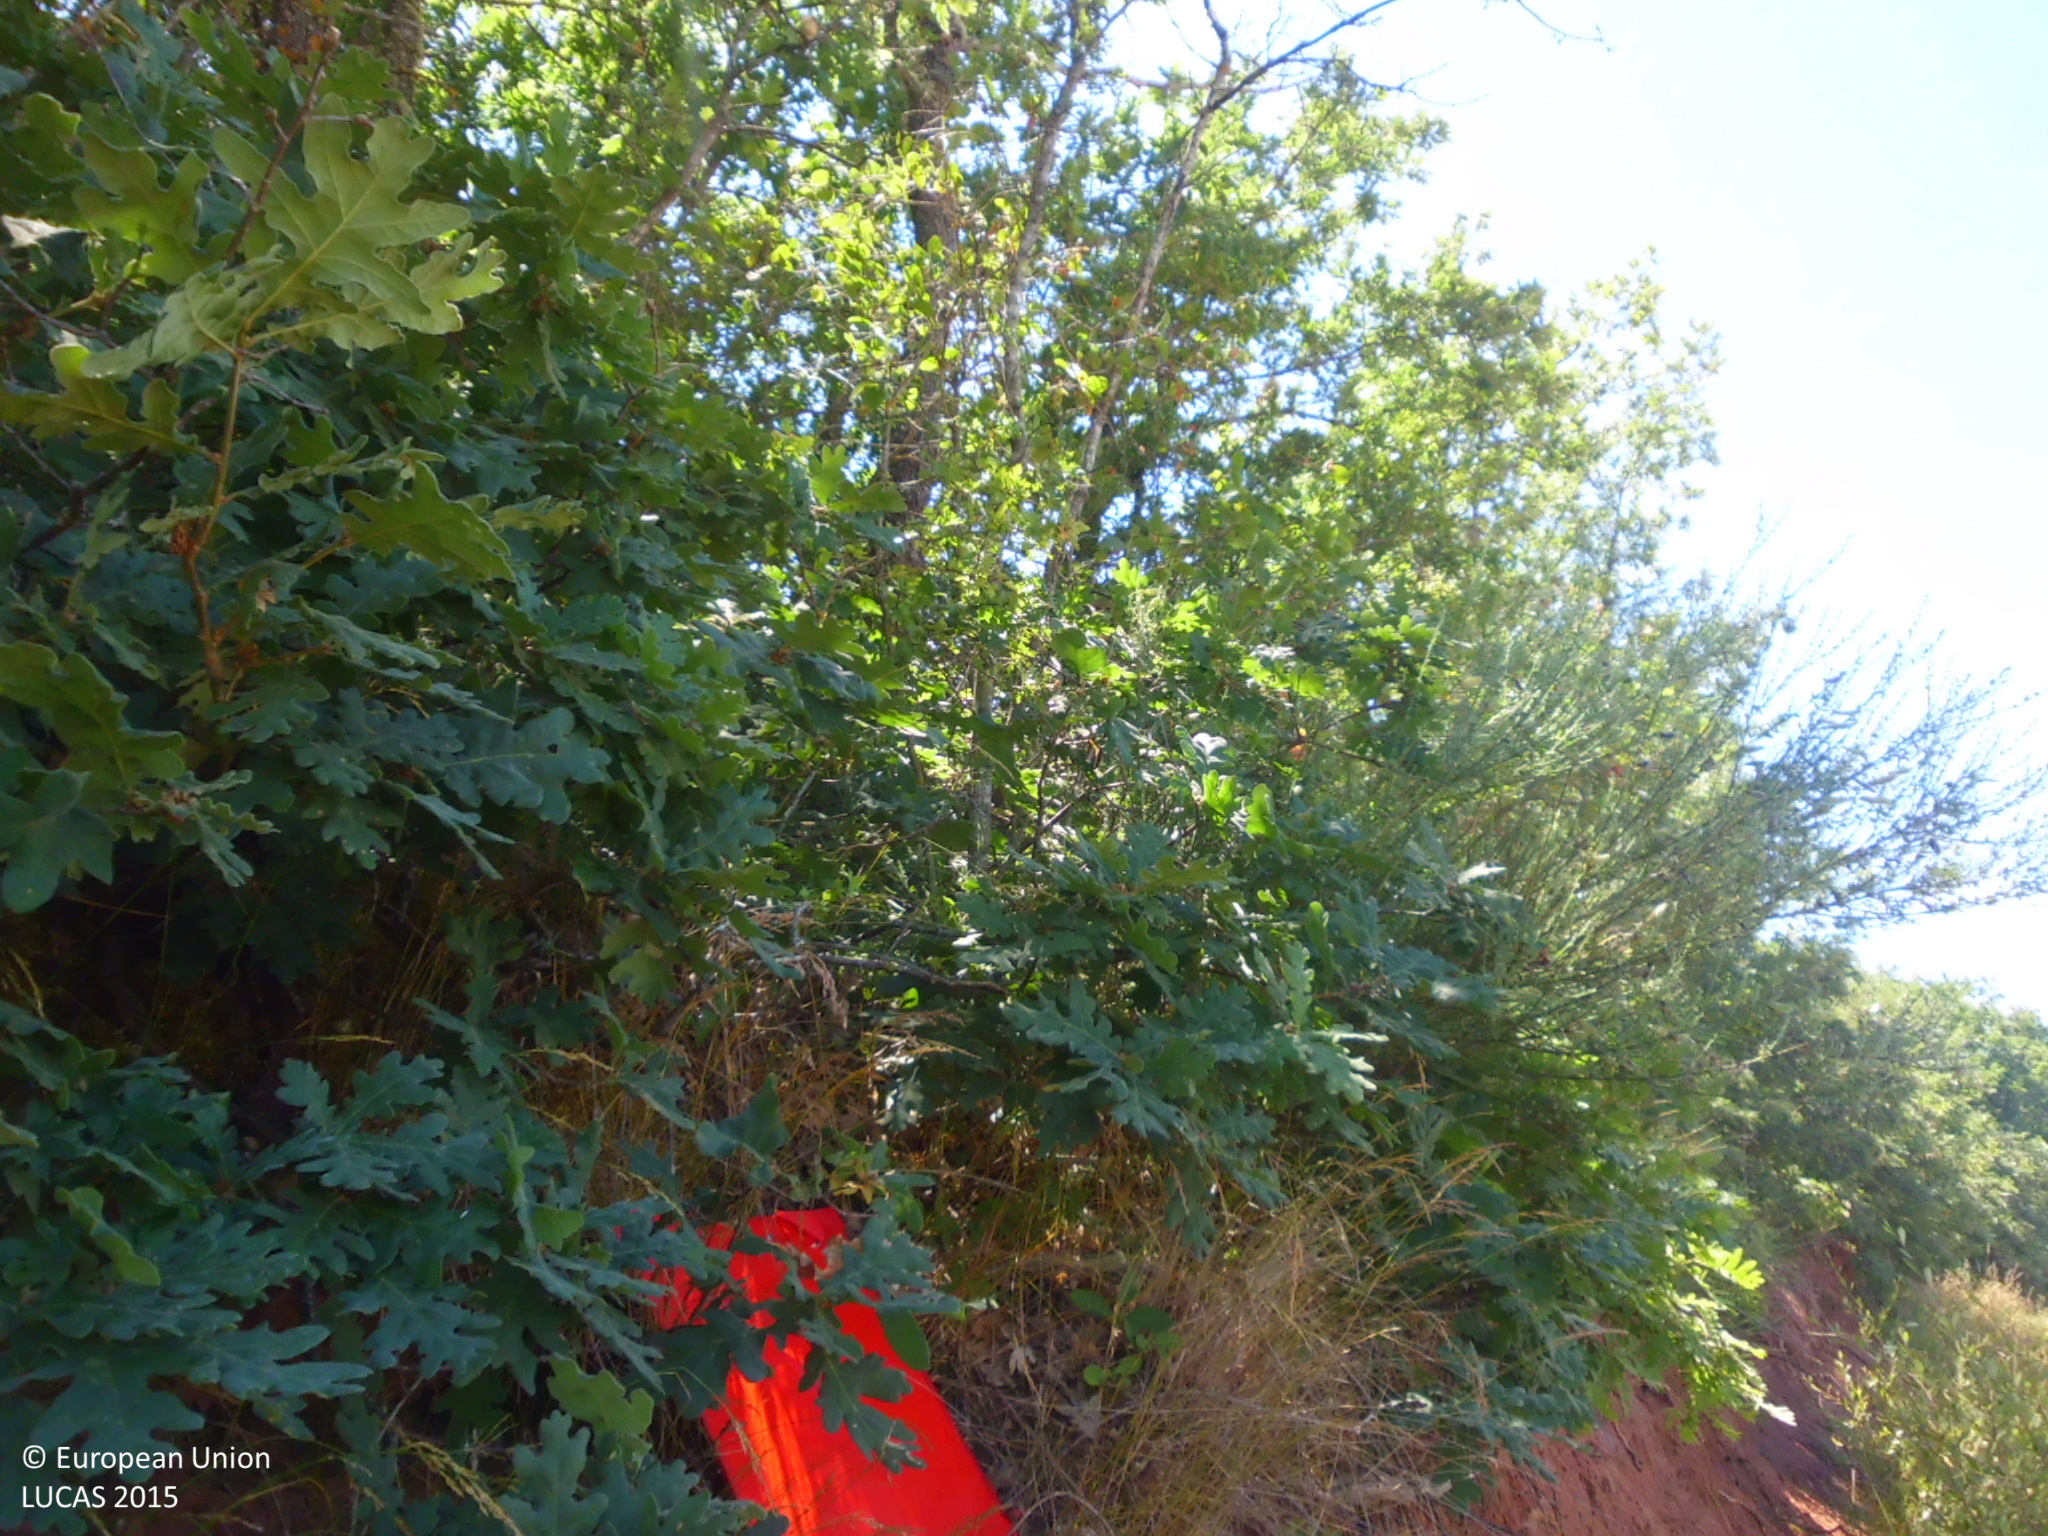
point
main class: Woodland
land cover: Broadleaved woodland
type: mesophytic deciduous forest
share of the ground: 50 - 75 %
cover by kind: broadleaved forest trees 50 %, herbaceous plants 20 %, consolidated bare surface 20 %, shrubs 10 %
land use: Semi-natural and natural areas not in use
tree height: > 5 m
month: July
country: ES
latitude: 42.7974
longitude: -4.0957
